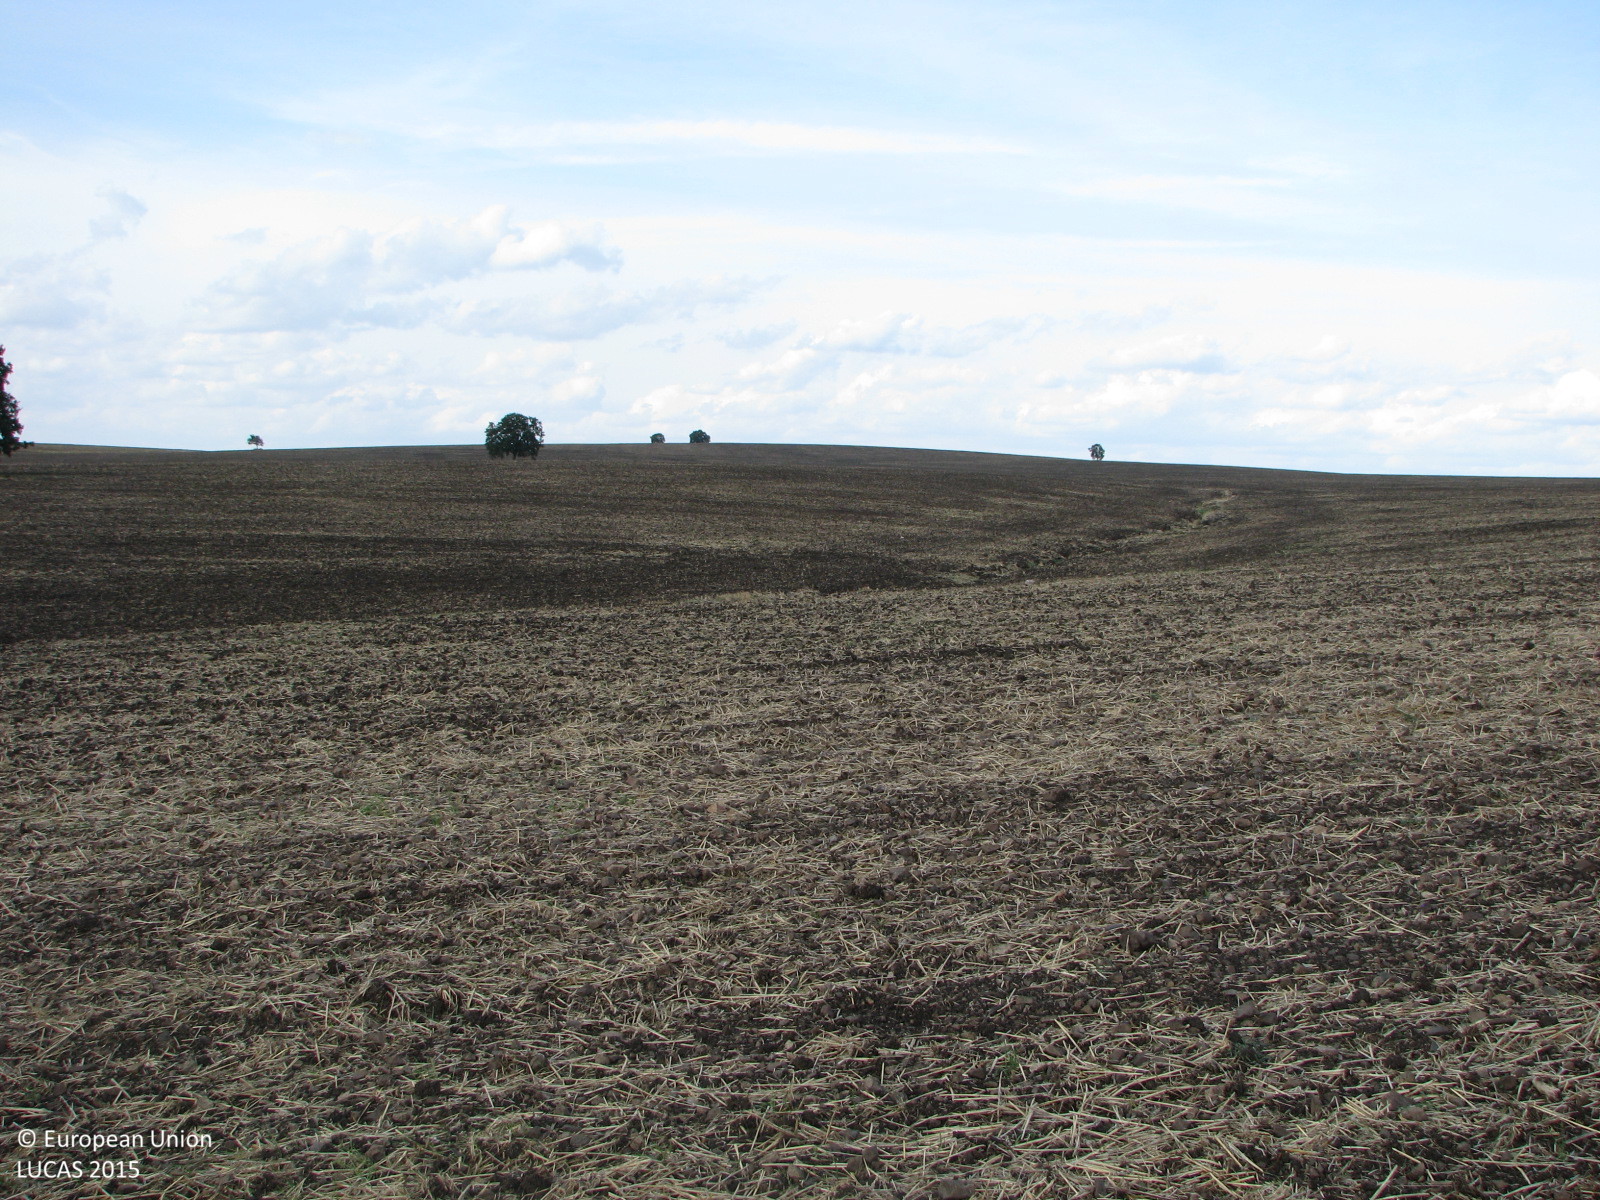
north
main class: Cropland
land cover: Common wheat
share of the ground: < 10 %
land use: Agriculture (excluding fallow land and kitchen gardens)
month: September
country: BG
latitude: 42.4642
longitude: 26.8468
